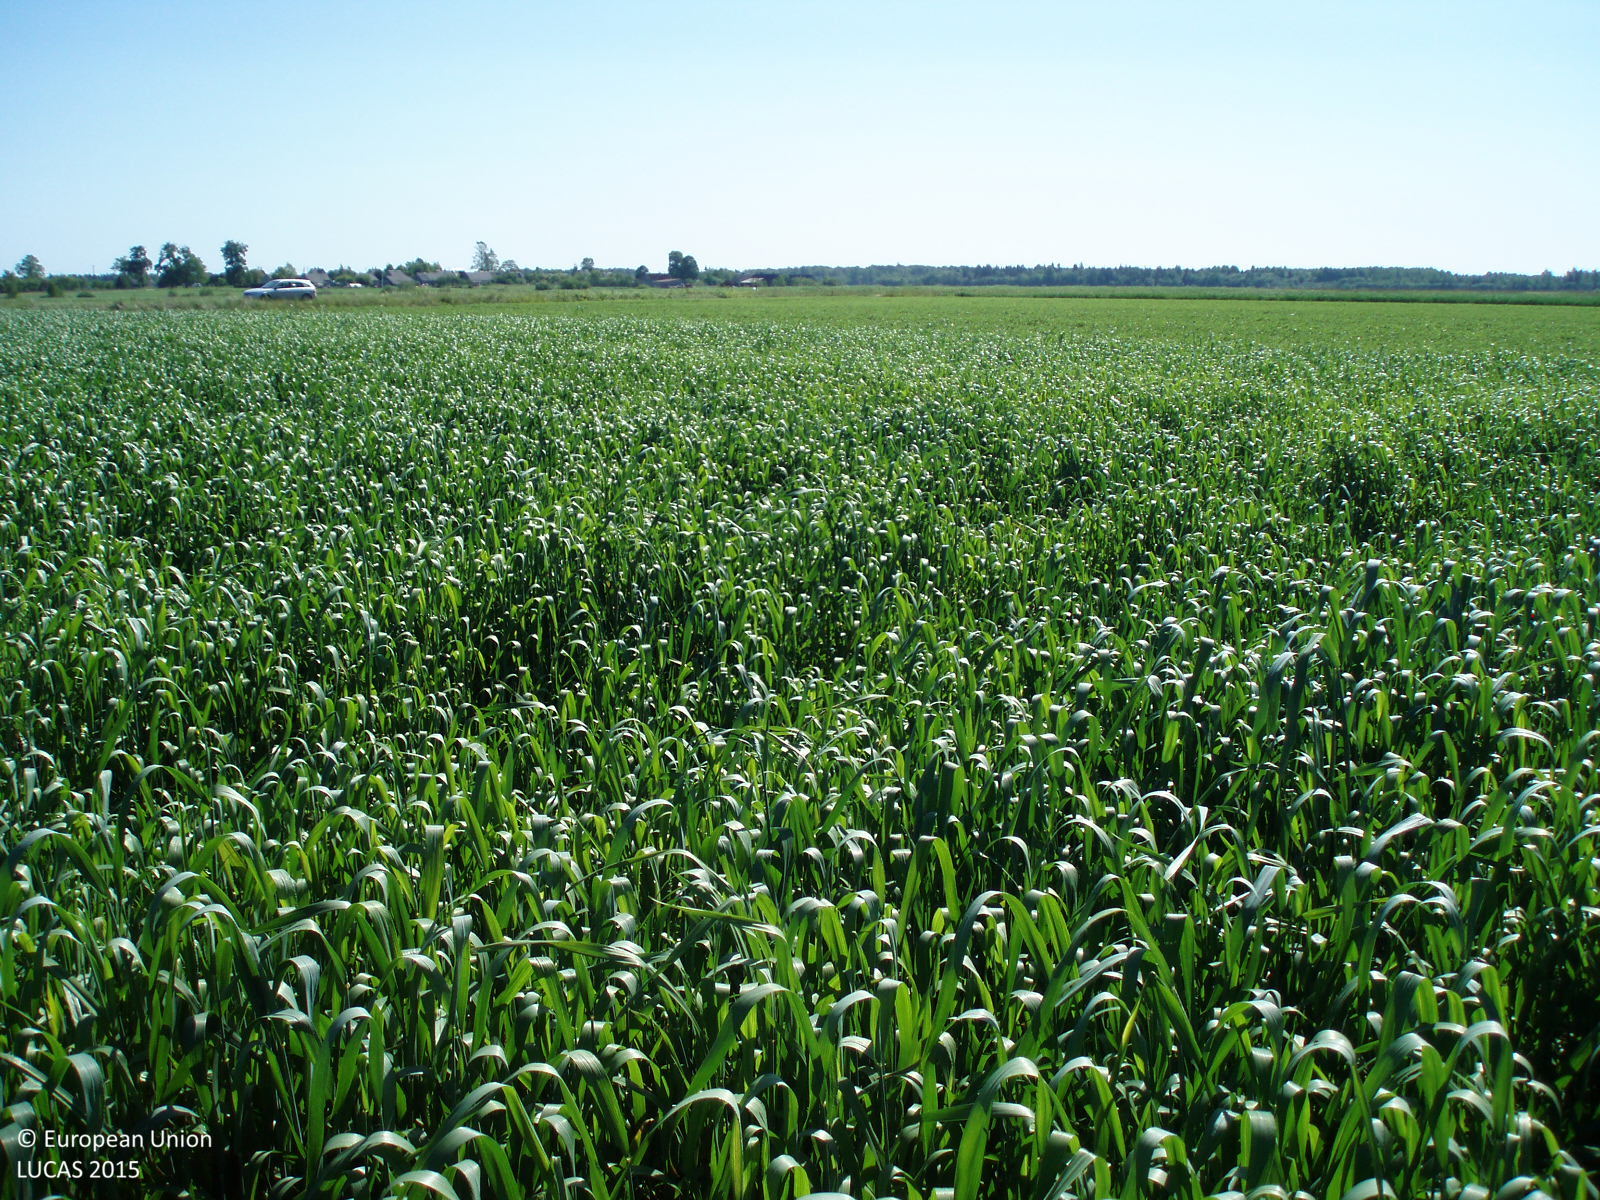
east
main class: Cropland
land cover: Rye
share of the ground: > 75 %
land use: Agriculture (excluding fallow land and kitchen gardens)
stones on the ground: < 10 %
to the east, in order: Rye; Dry pulses; Ditches and canals; Paved roads, cycling and walking lanes; Ditches and canals; Tracks; Rye
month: June
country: LT
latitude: 56.1567
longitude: 22.8643
